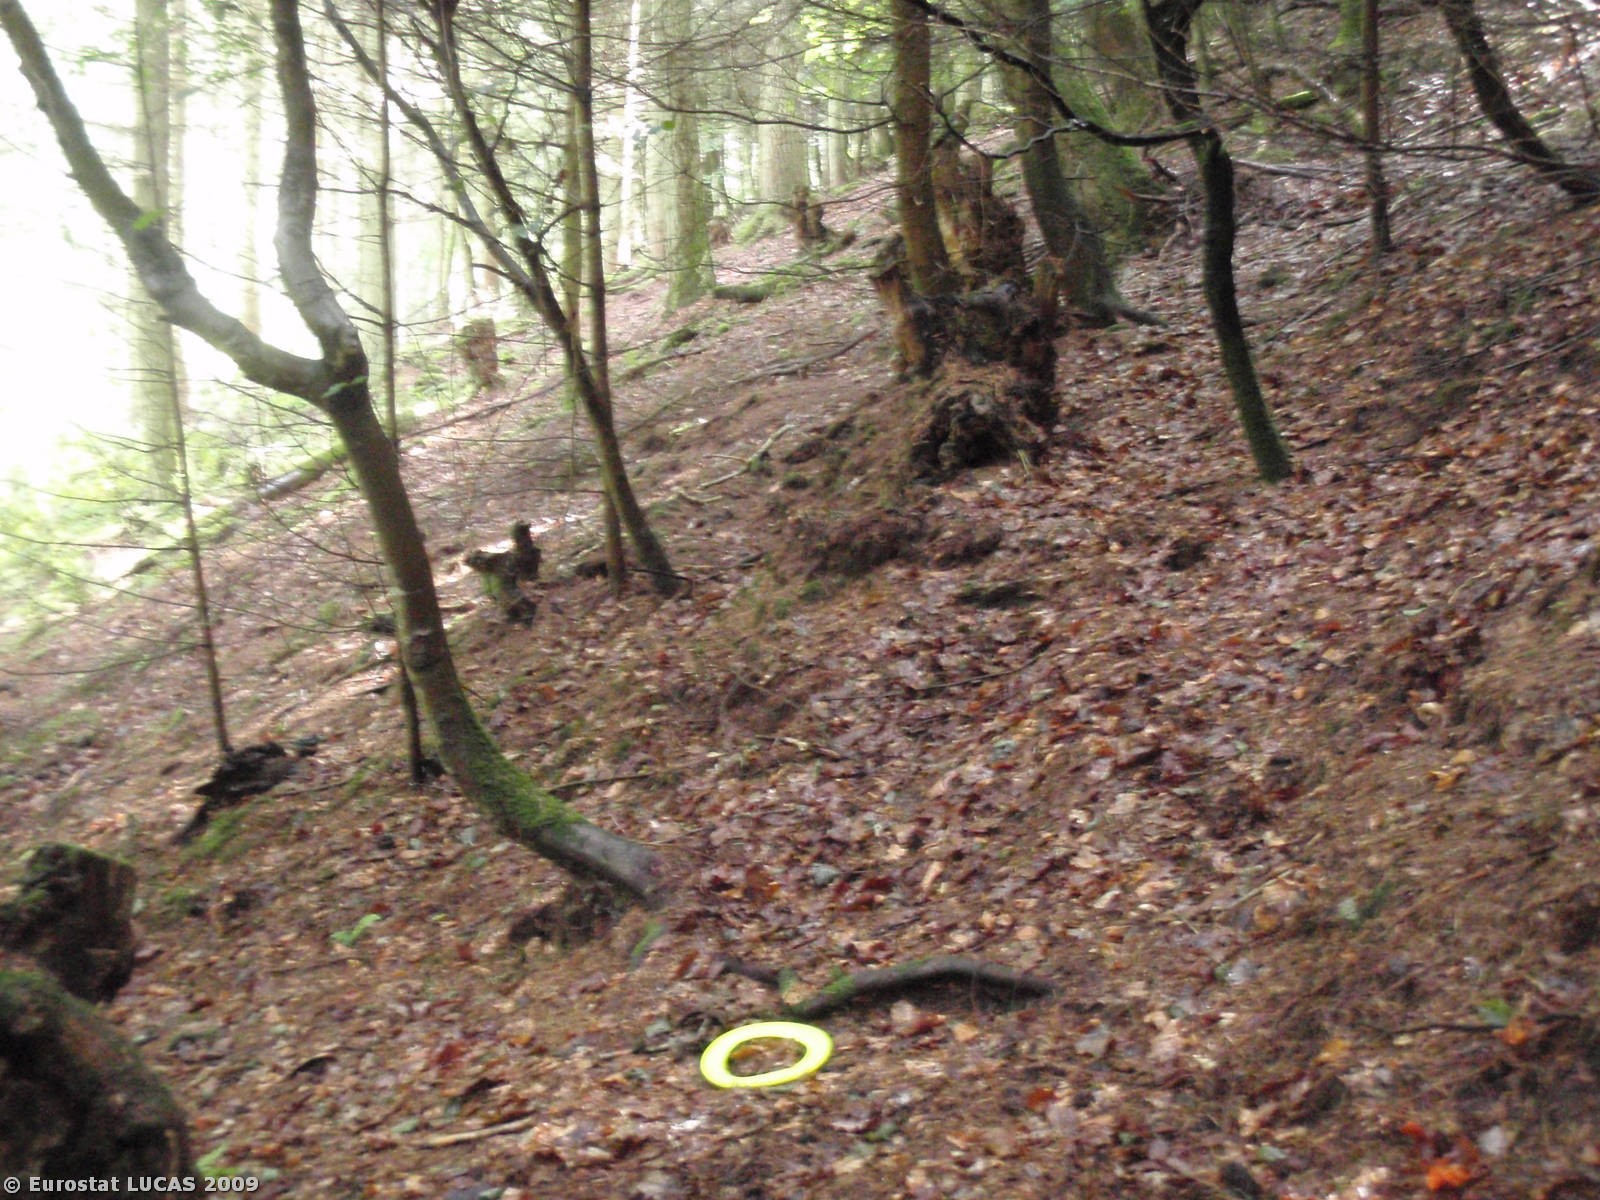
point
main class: Woodland
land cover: Coniferous woodland
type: plantations and self-sown exotic forest
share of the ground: > 75 %
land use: Forestry
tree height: > 5 m
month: August
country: GB
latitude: 51.1691
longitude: -3.4557
